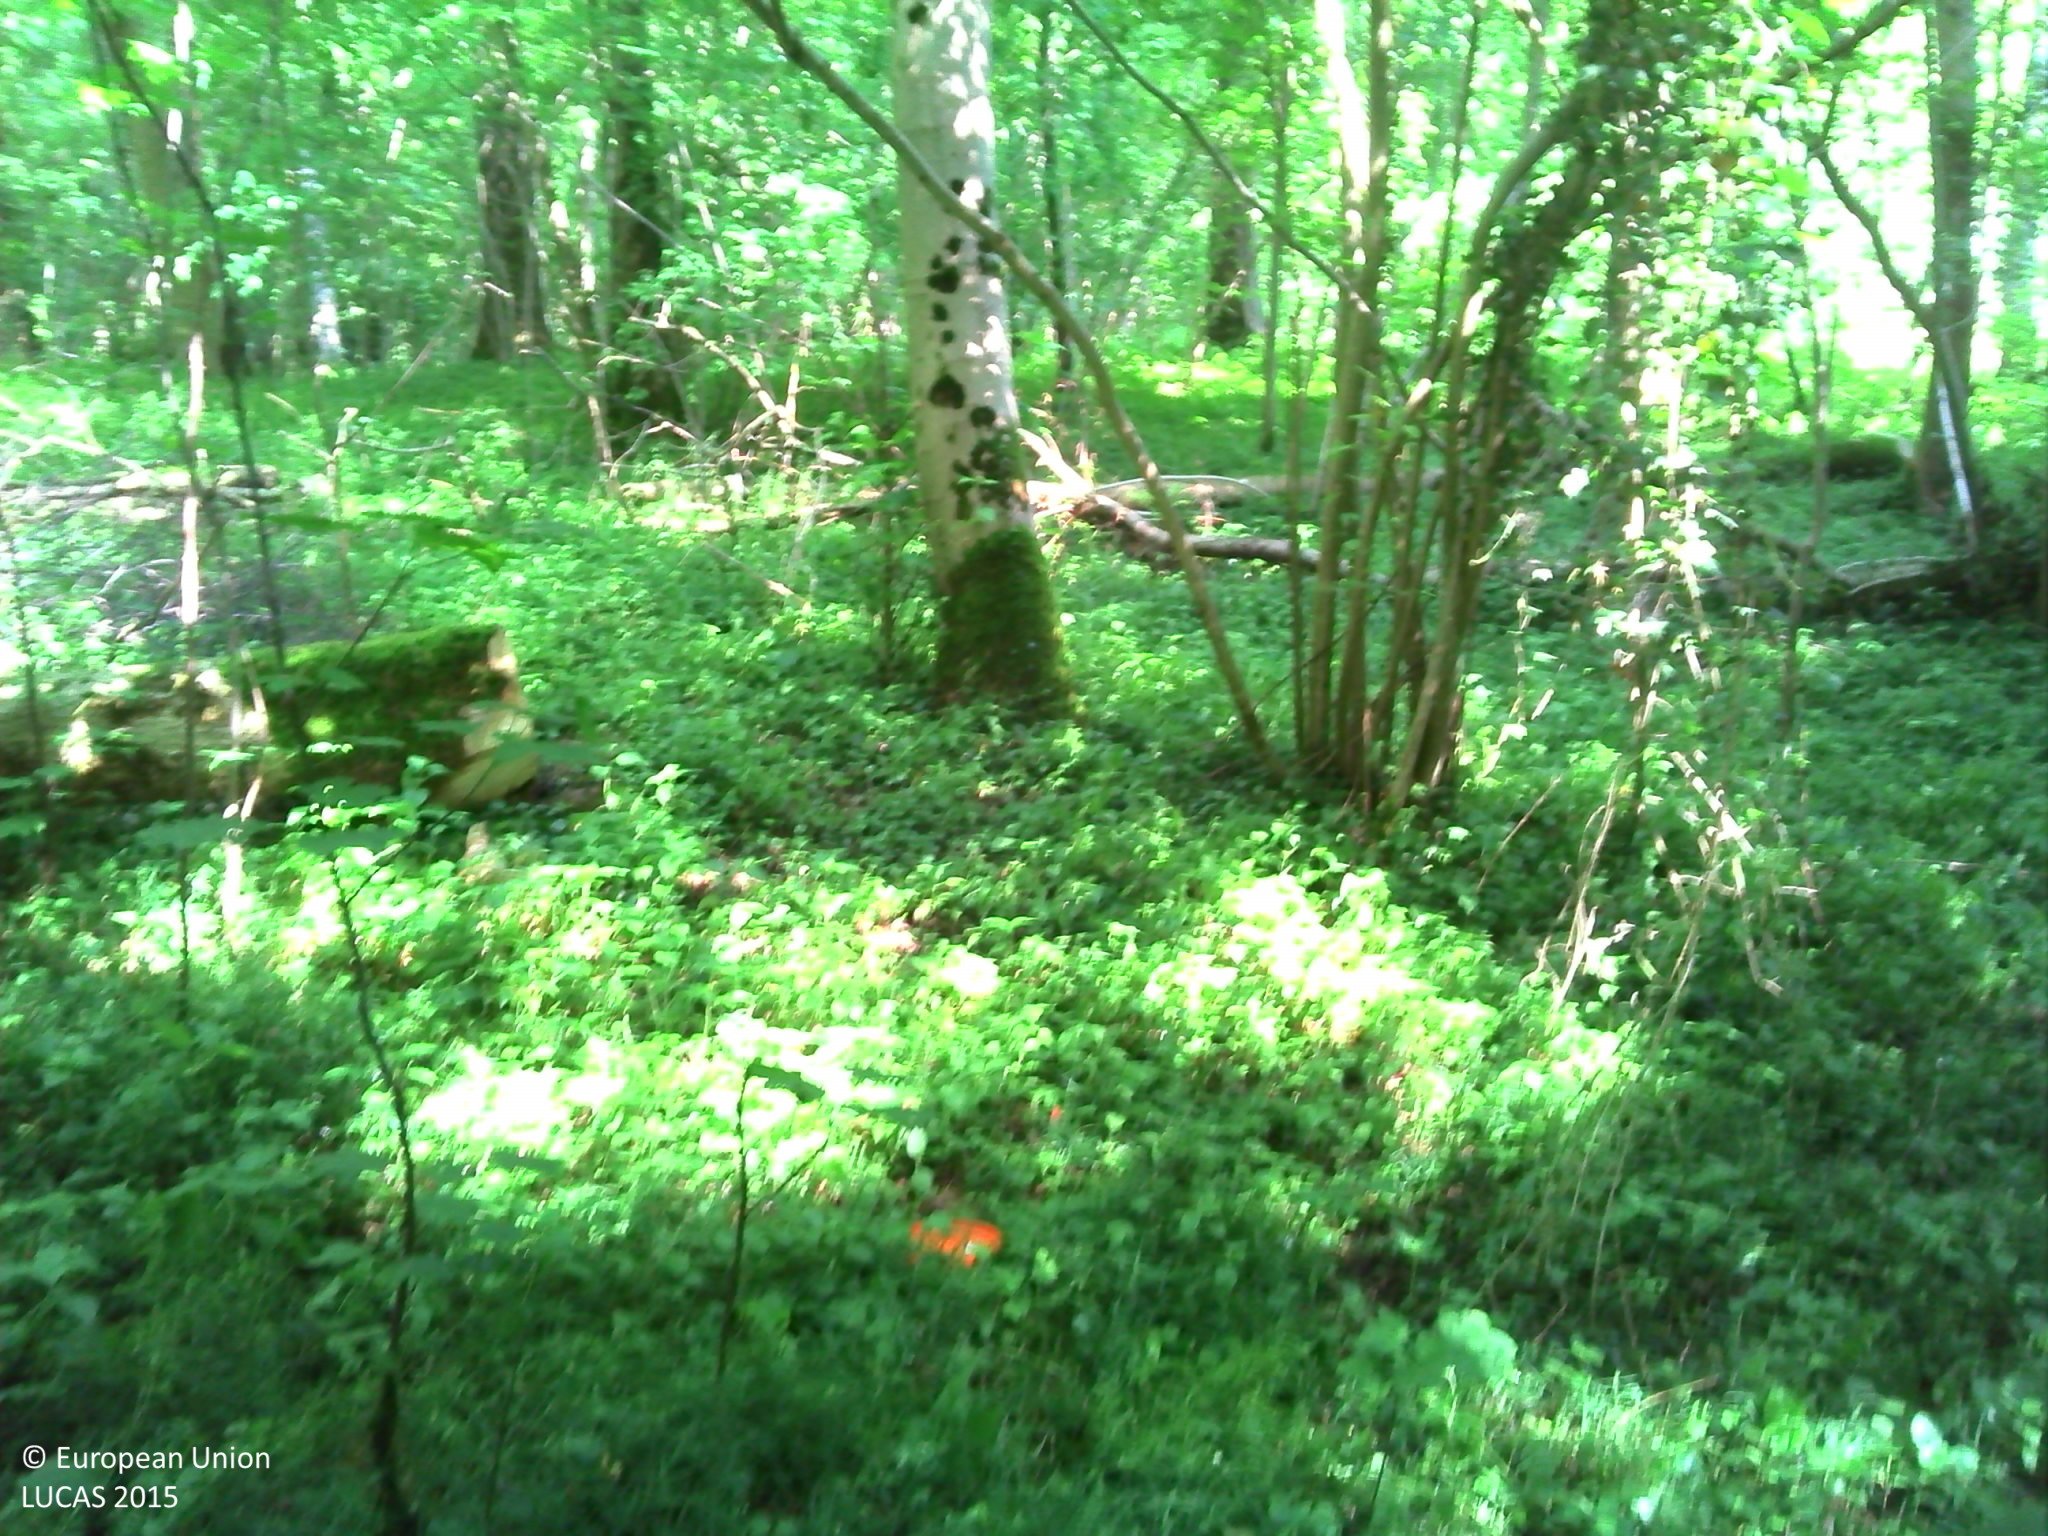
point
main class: Woodland
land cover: Broadleaved woodland
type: mesophytic deciduous forest
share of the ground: > 75 %
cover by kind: broadleaved forest trees 85 %, herbaceous plants 15 %
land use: Forestry
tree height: > 5 m
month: June
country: BE
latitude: 50.3788
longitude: 3.8485
